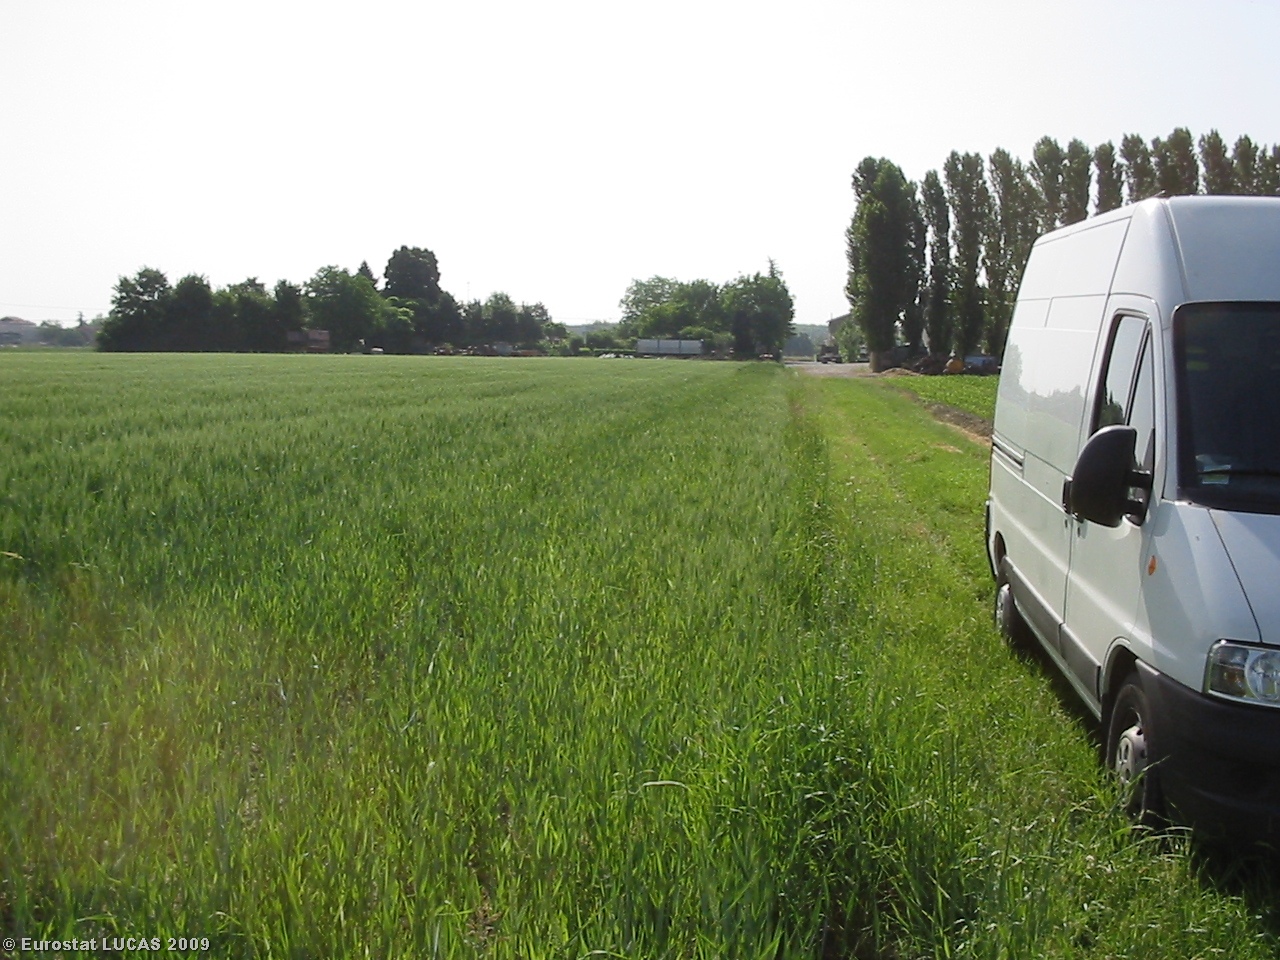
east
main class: Cropland
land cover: Common wheat
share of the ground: > 75 %
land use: Agriculture (excluding fallow land and kitchen gardens)
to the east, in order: Common wheat; Managed hedges; Ditches and canals; Sugar beet; Artificial constructions; Grass margins; Ditches and canals; Grass margins; Paved roads, cycling and walking lanes; Grass margins; Ditches and canals; Grass margins; Artificial constructions; Sugar beet
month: May
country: IT
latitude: 44.8545
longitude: 10.4420
